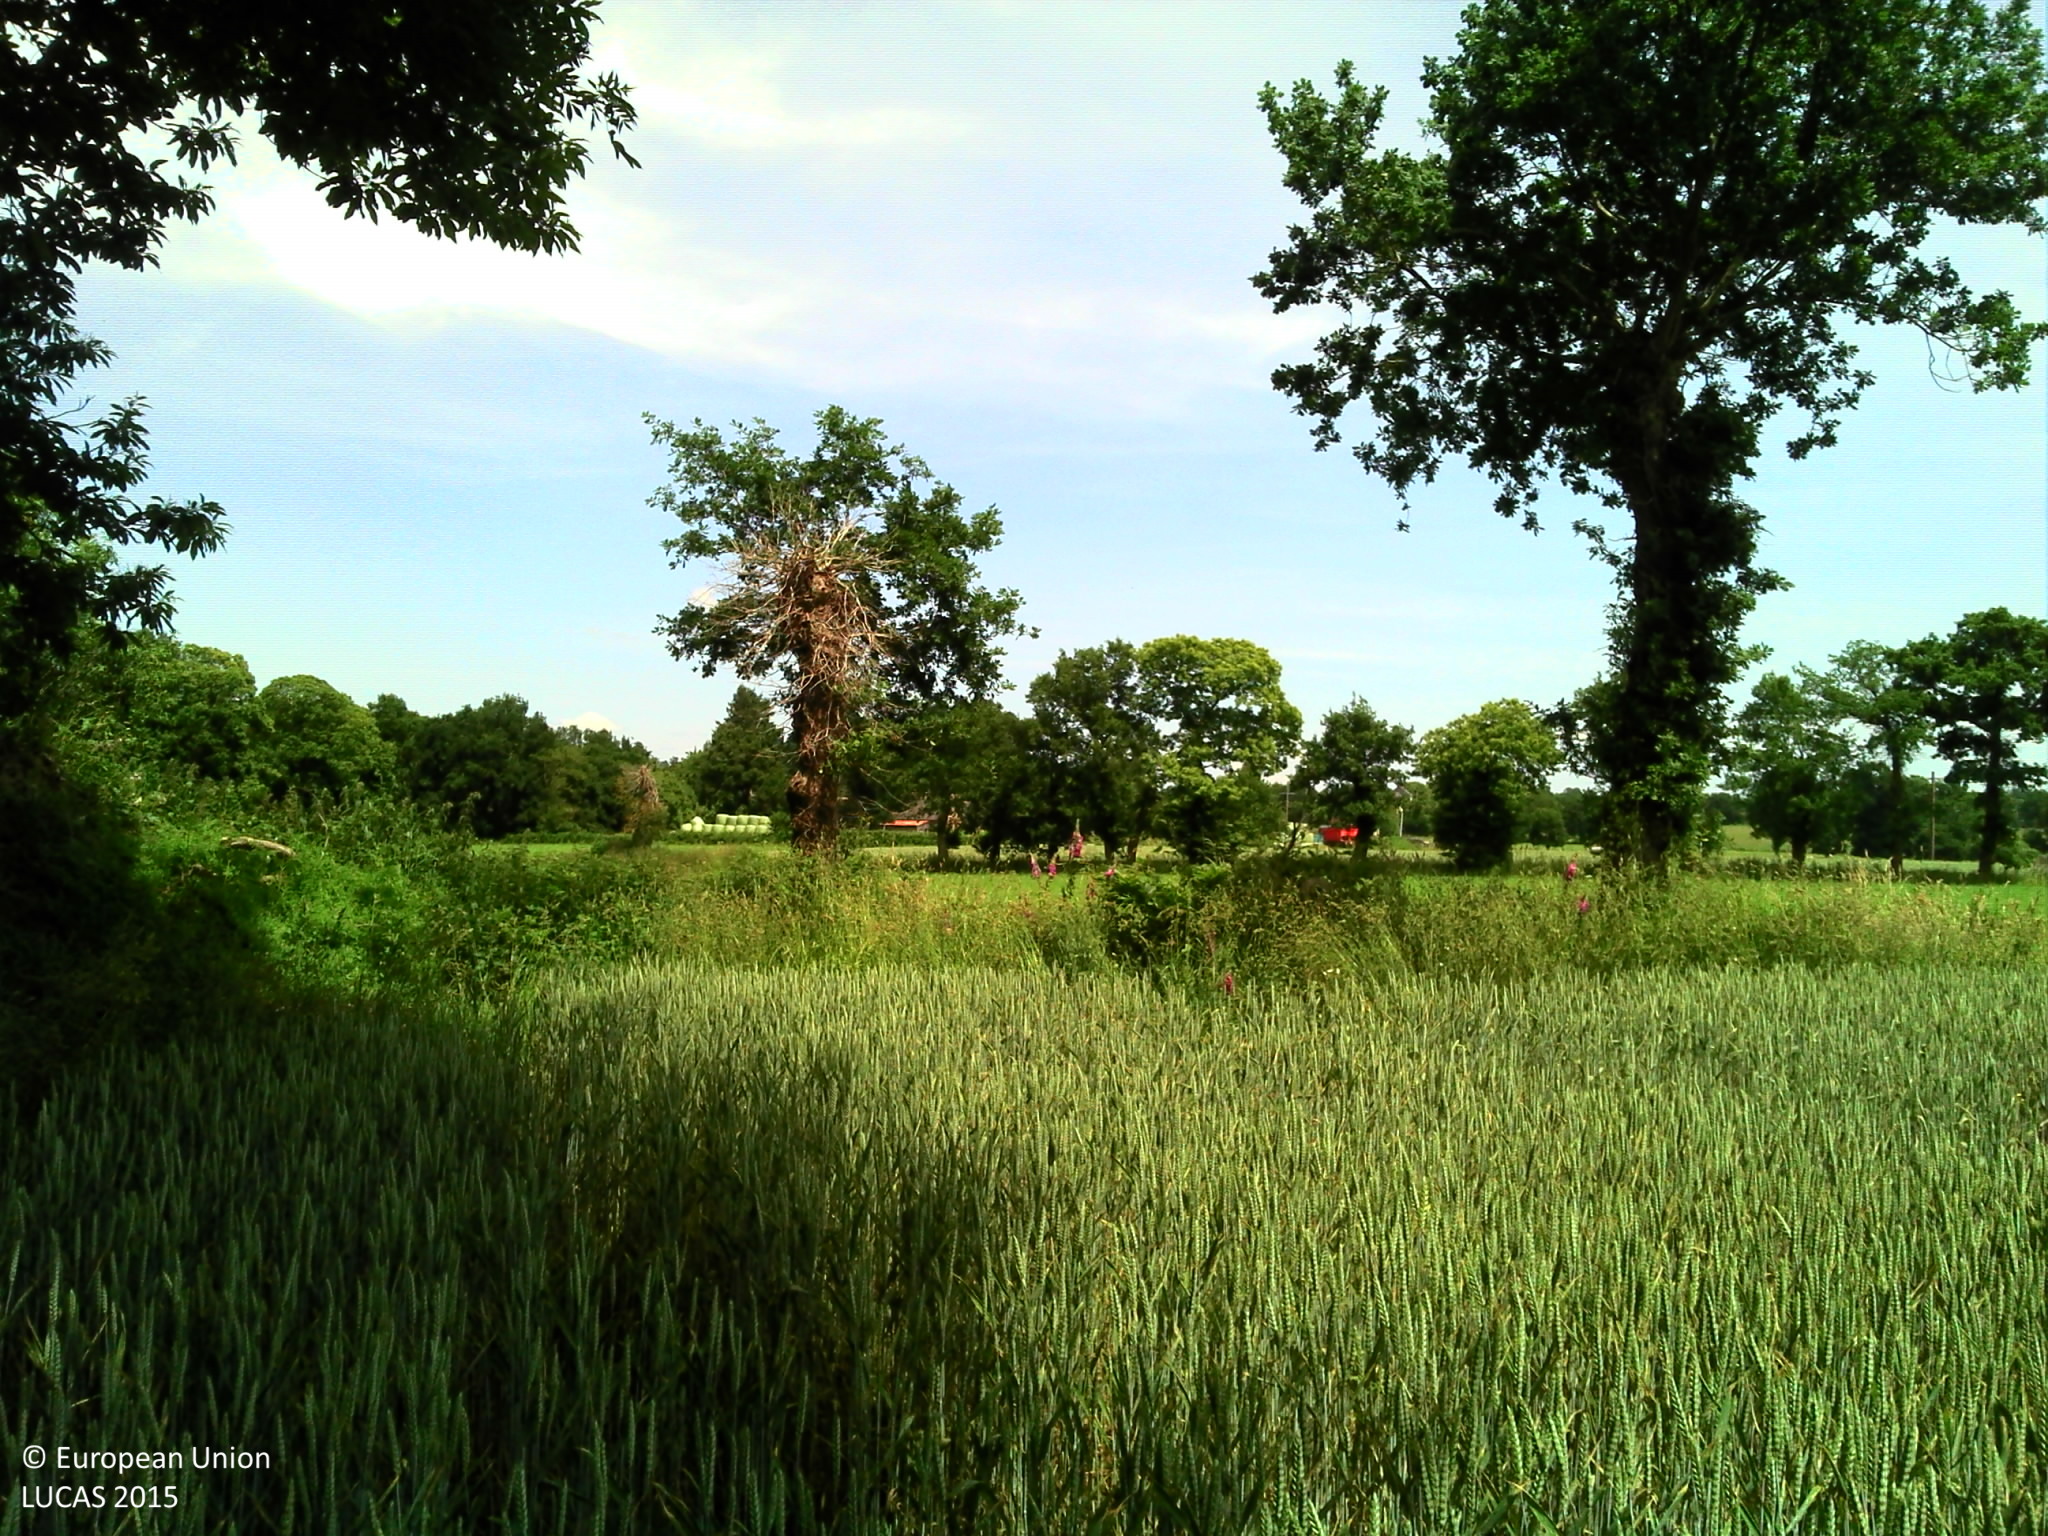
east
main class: Cropland
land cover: Common wheat
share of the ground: > 75 %
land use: Agriculture (excluding fallow land and kitchen gardens)
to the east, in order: Common wheat; Grass margins; Common wheat; Grass margins; Lines of trees; Common wheat; Grass margins; Paved roads, cycling and walking lanes; Grass margins; Ditches and canals; Common wheat
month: June
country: FR
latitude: 48.3668
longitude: -1.4794
